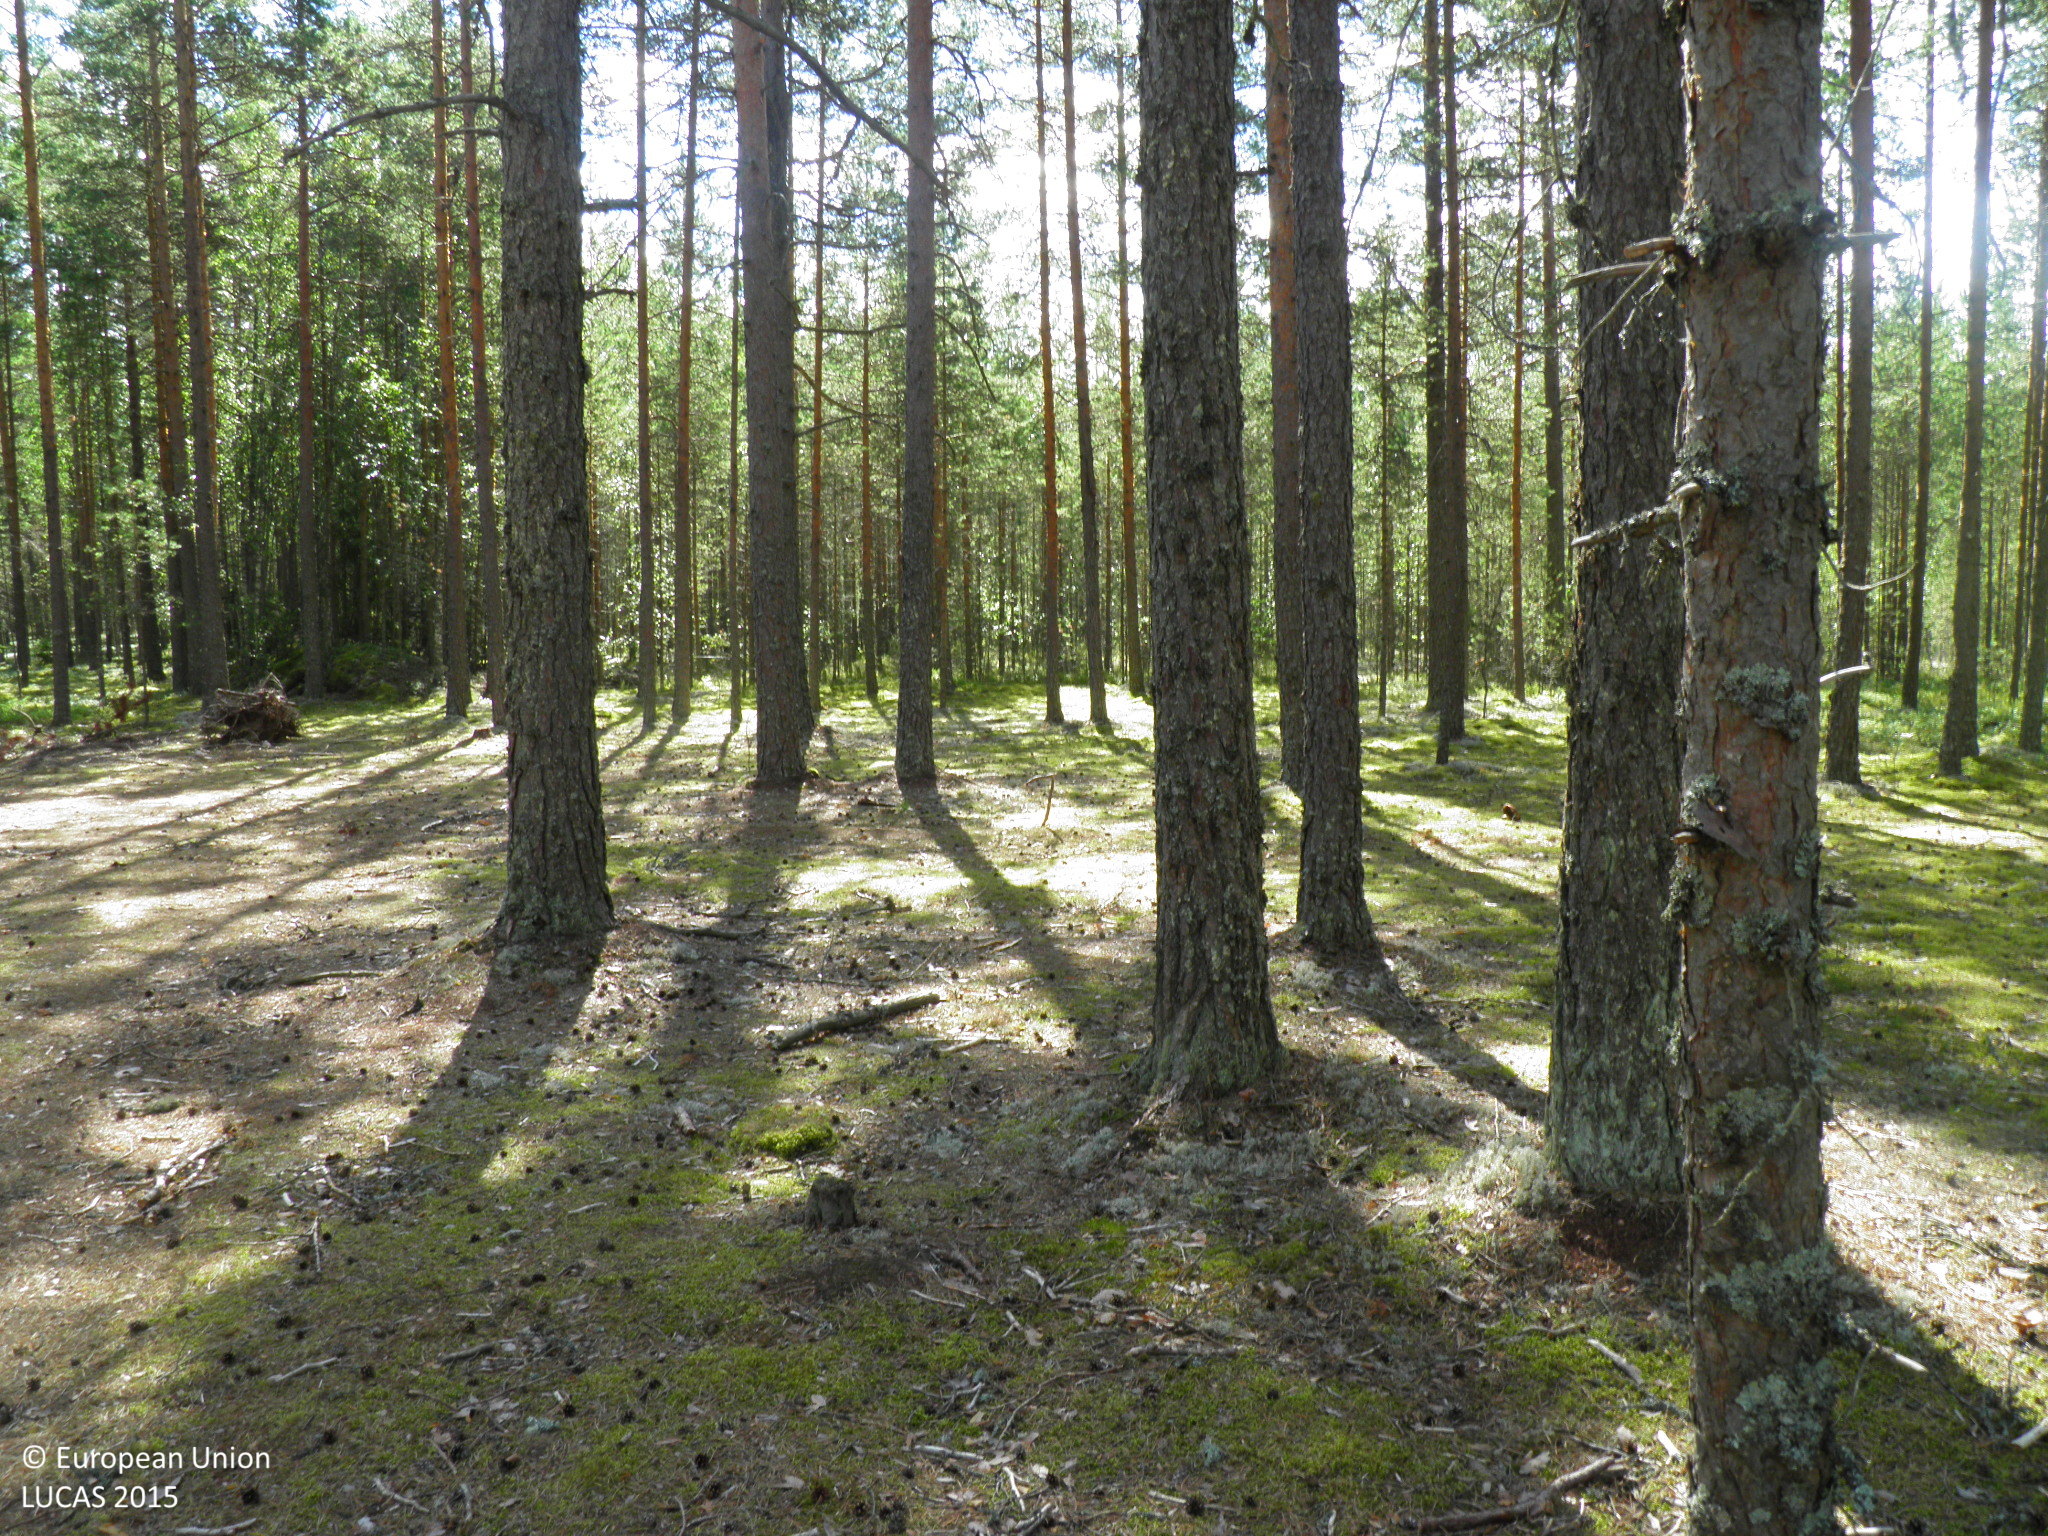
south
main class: Woodland
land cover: Pine dominated coniferous woodland
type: hemiboreal forest and nemoral coniferous forest and mixed broadleaved-coniferous forest
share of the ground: 50 - 75 %
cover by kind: coniferous forest trees 50 %, lichens and mosses 25 %, unconsolidated bare surface 25 %
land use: Forestry
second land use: Amenities, museums, leisure
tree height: > 5 m
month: August
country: FI
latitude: 60.9881
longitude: 22.5443
